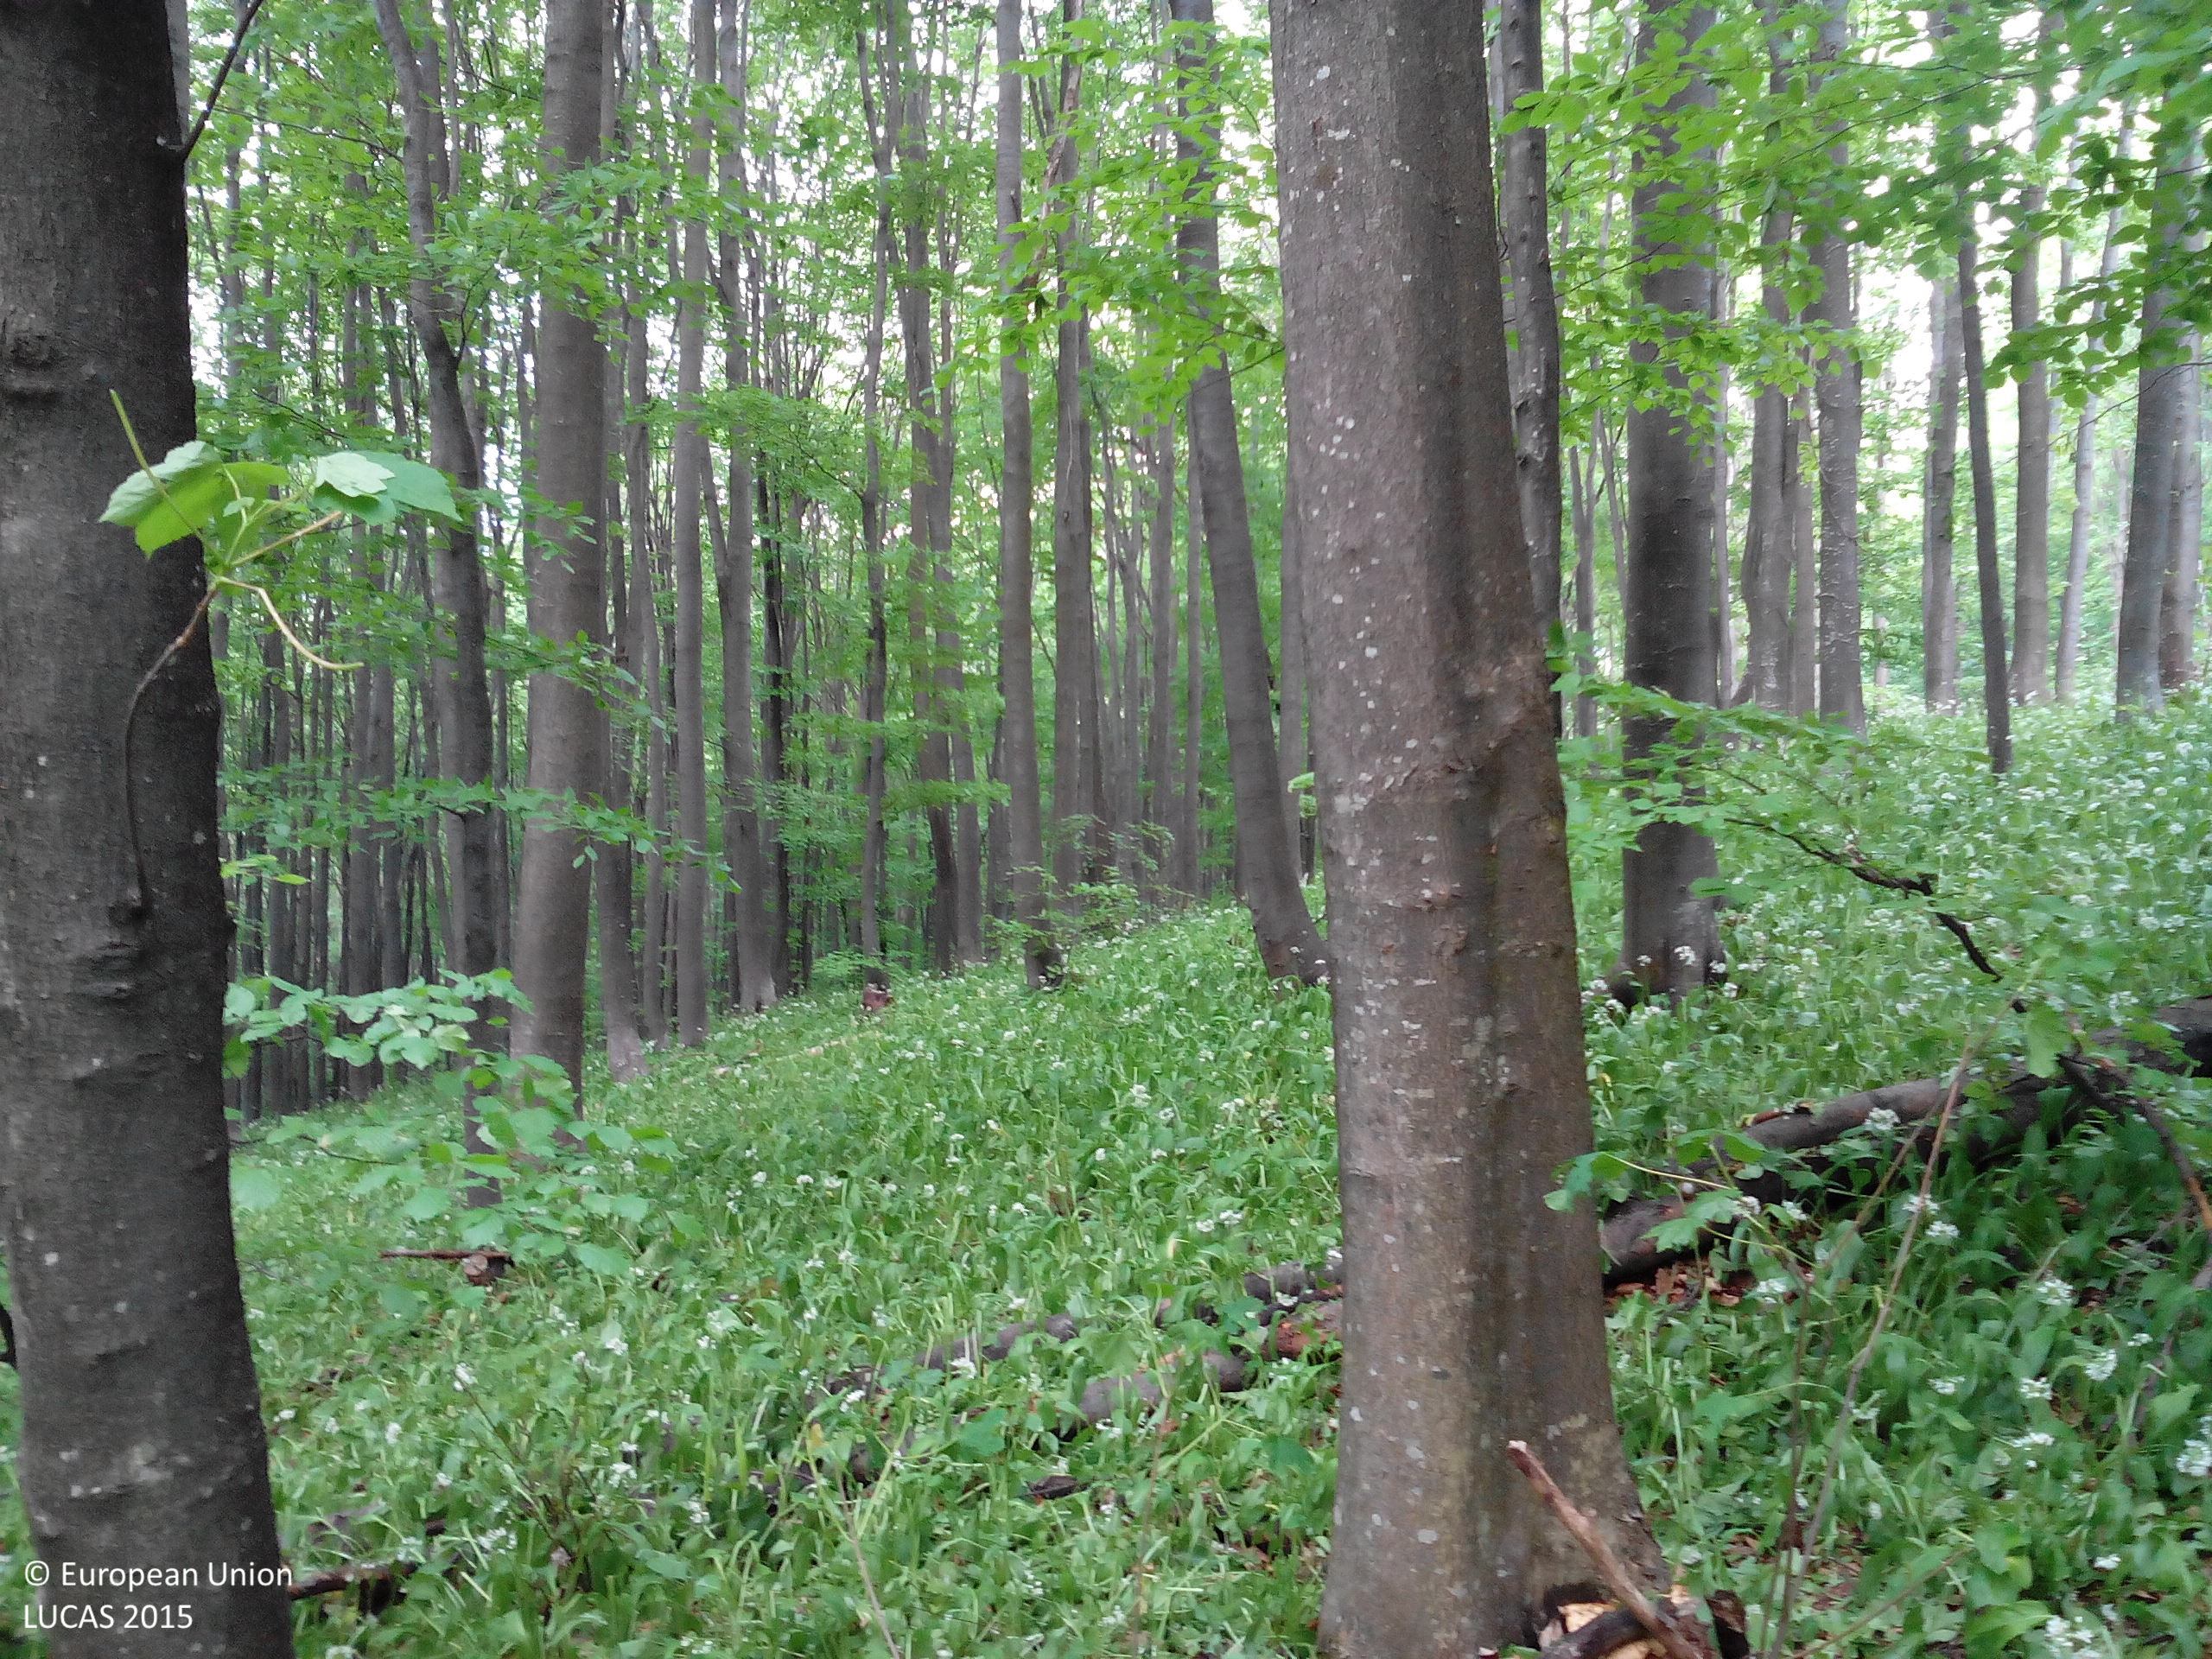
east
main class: Woodland
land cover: Broadleaved woodland
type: beech forest
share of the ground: > 75 %
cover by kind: broadleaved forest trees 95 %, herbaceous plants 5 %
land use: Forestry
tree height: > 5 m
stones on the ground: 10 - 25 %
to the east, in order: Broadleaved woodland; Grass margins; Tracks; Grass margins; Broadleaved woodland
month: May
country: BG
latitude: 43.1587
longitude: 23.4584
